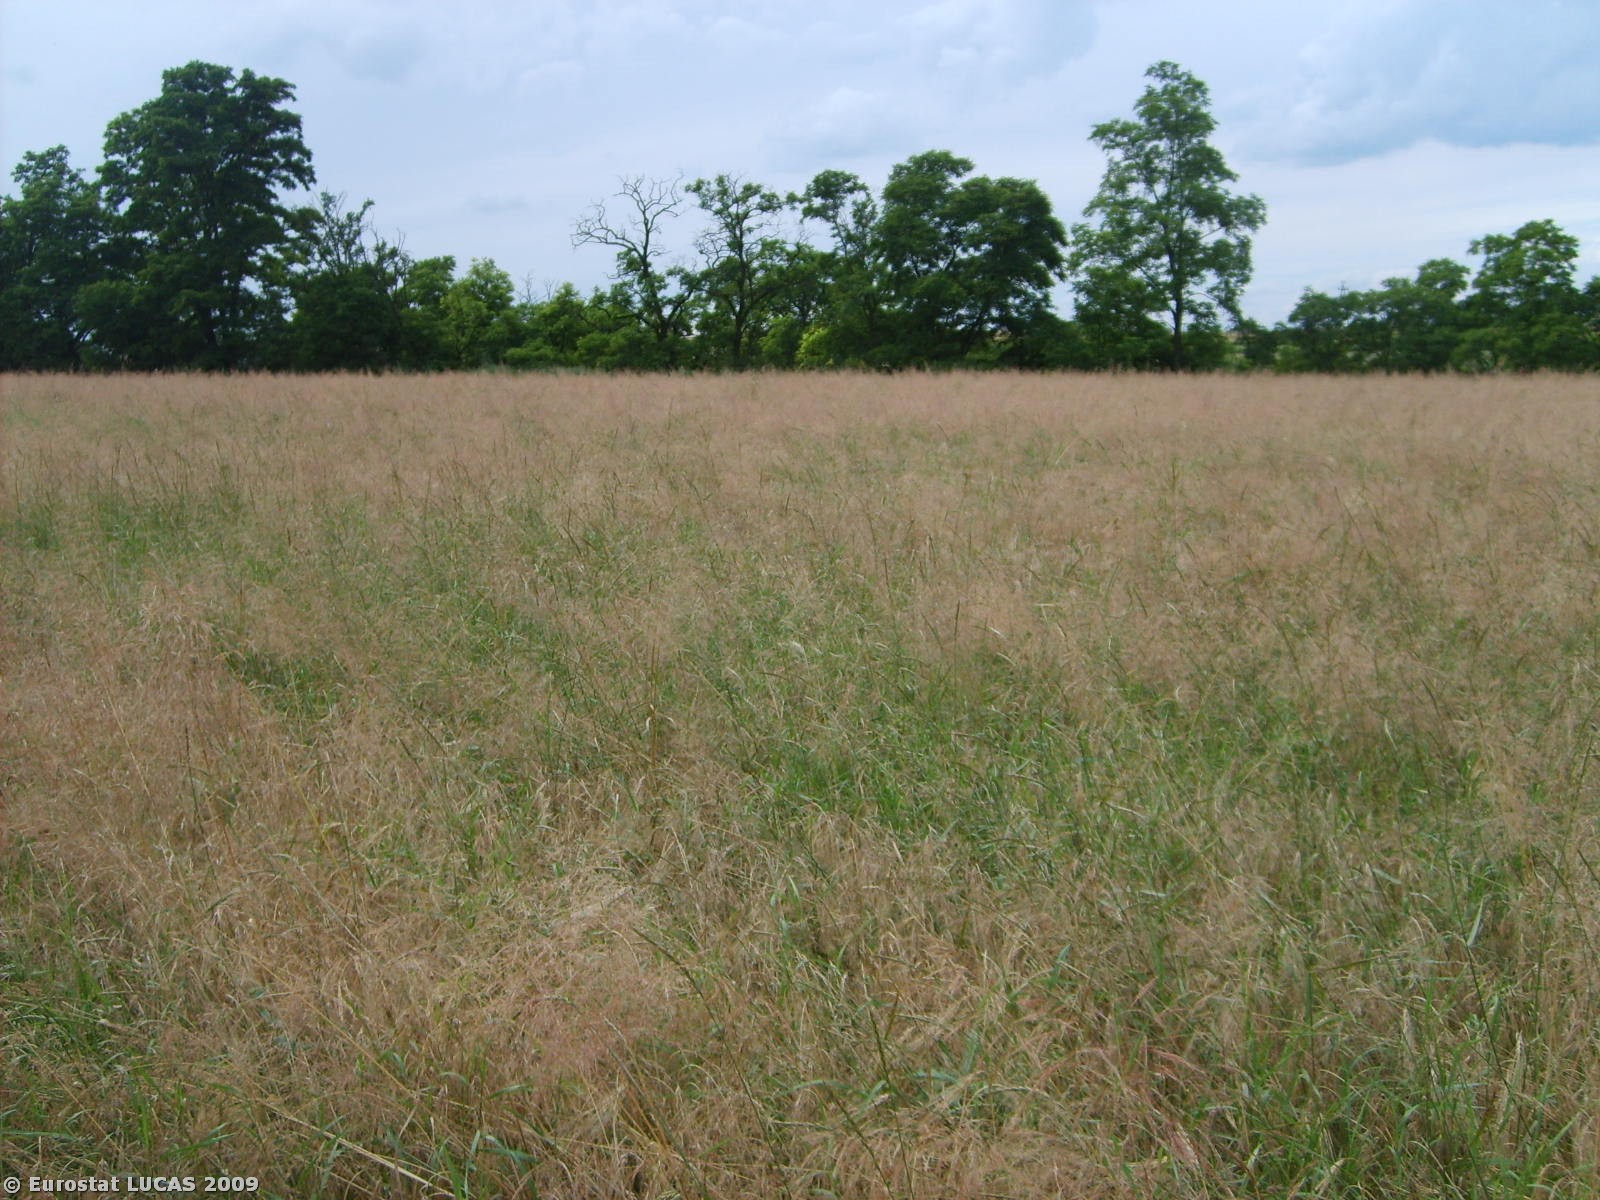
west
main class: Cropland
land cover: Barley
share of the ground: > 75 %
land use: Agriculture (excluding fallow land and kitchen gardens)
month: July
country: PL
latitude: 50.3169
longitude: 20.6711
